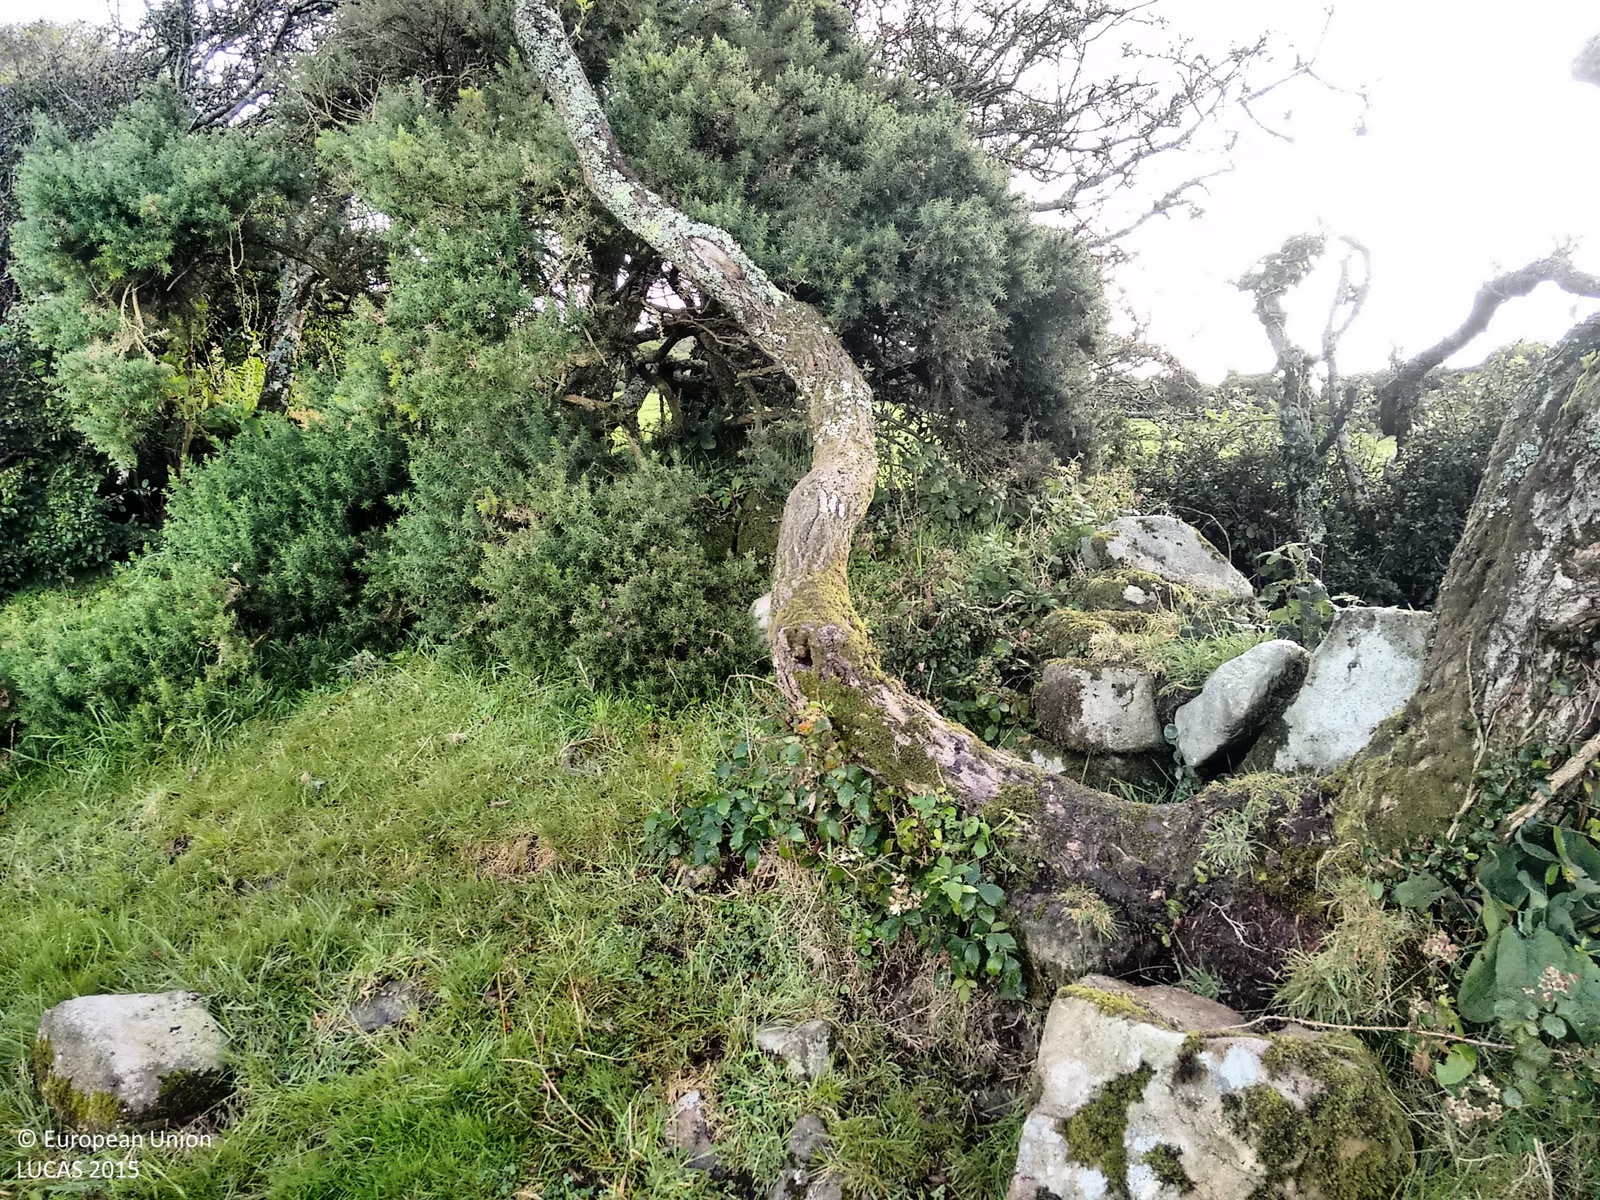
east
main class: Grassland
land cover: Grassland without tree/shrub cover
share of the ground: > 75 %
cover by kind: herbaceous plants 100 %
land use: Agriculture (excluding fallow land and kitchen gardens)
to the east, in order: Managed hedges; Artificial constructions; Grassland without tree/shrub cover; Electric lines; Grassland without tree/shrub cover; Abandoned hedges; Artificial constructions; Grassland without tree/shrub cover; Shrubland without tree cover; Fences; Dry stone walls; Spontaneously vegetated surfaces; Abandoned hedges; Tracks; Abandoned hedges
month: August
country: GB
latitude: 50.1757
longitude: -5.5167
